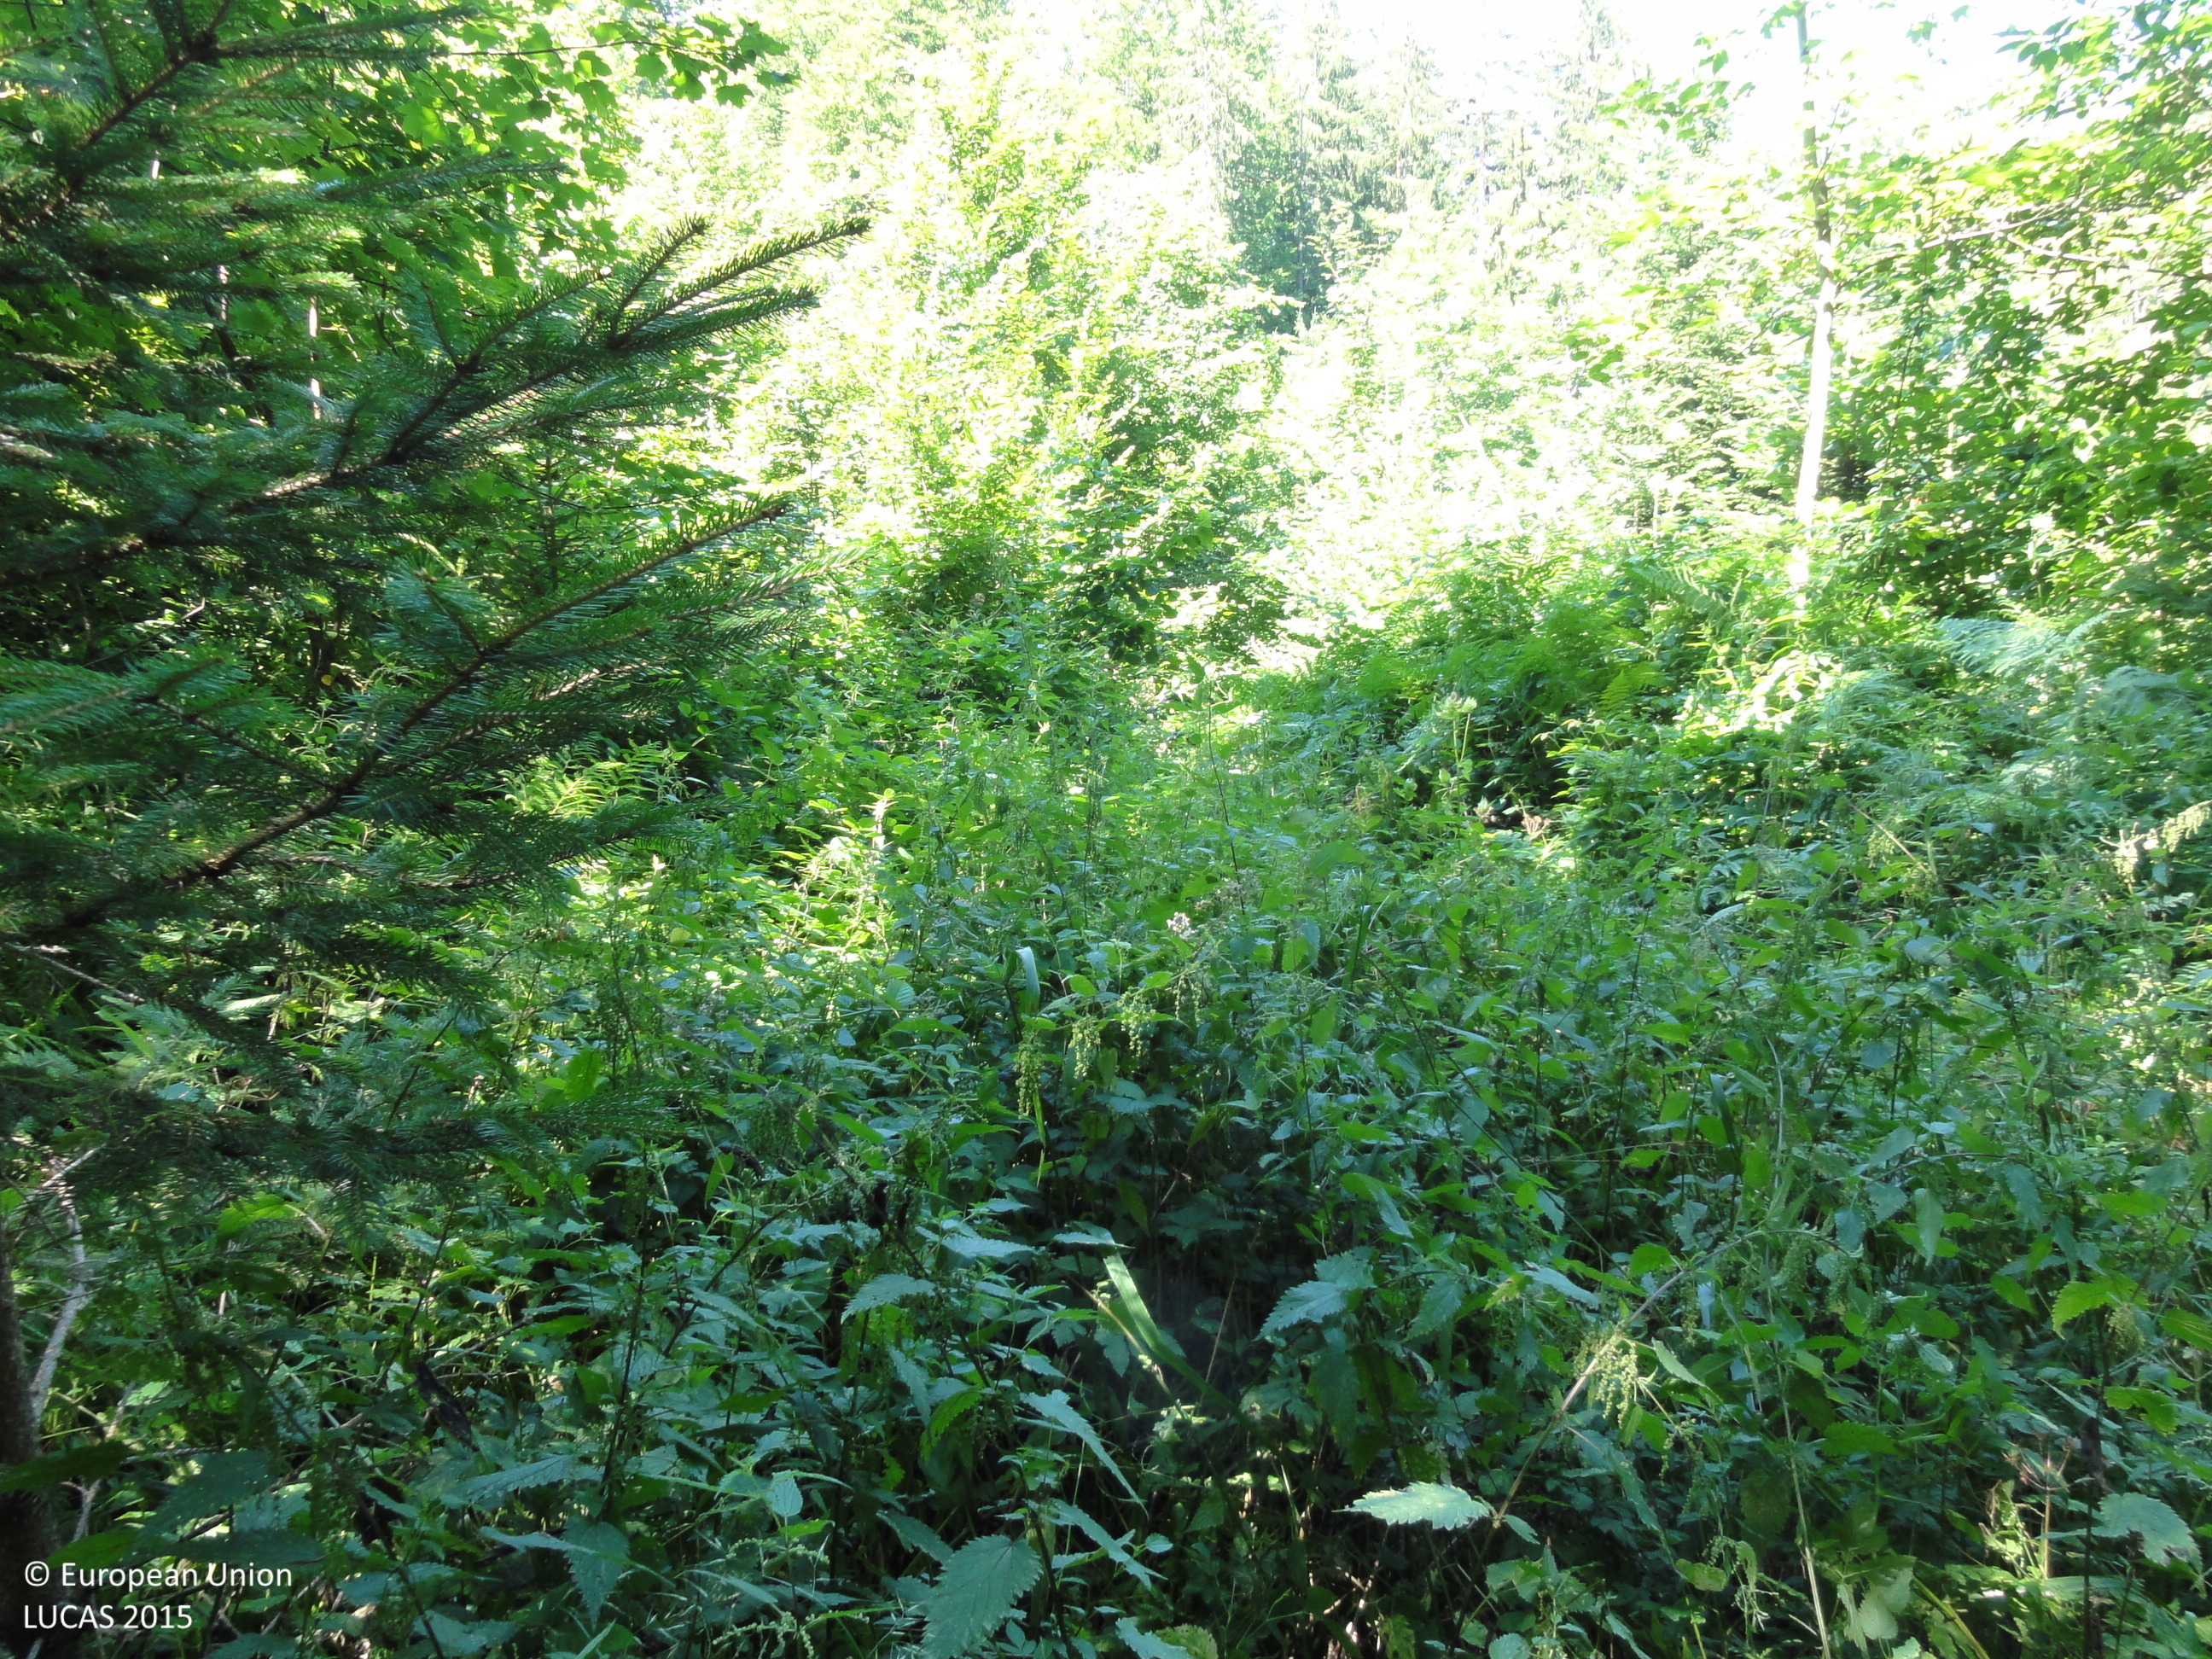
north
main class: Woodland
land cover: Spruce dominated mixed woodland
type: mountainous beech forest
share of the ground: > 75 %
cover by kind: coniferous forest trees 50 %, broadleaved forest trees 50 %
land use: Forestry
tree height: > 5 m
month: July
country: SI
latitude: 46.3389
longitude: 15.0775
